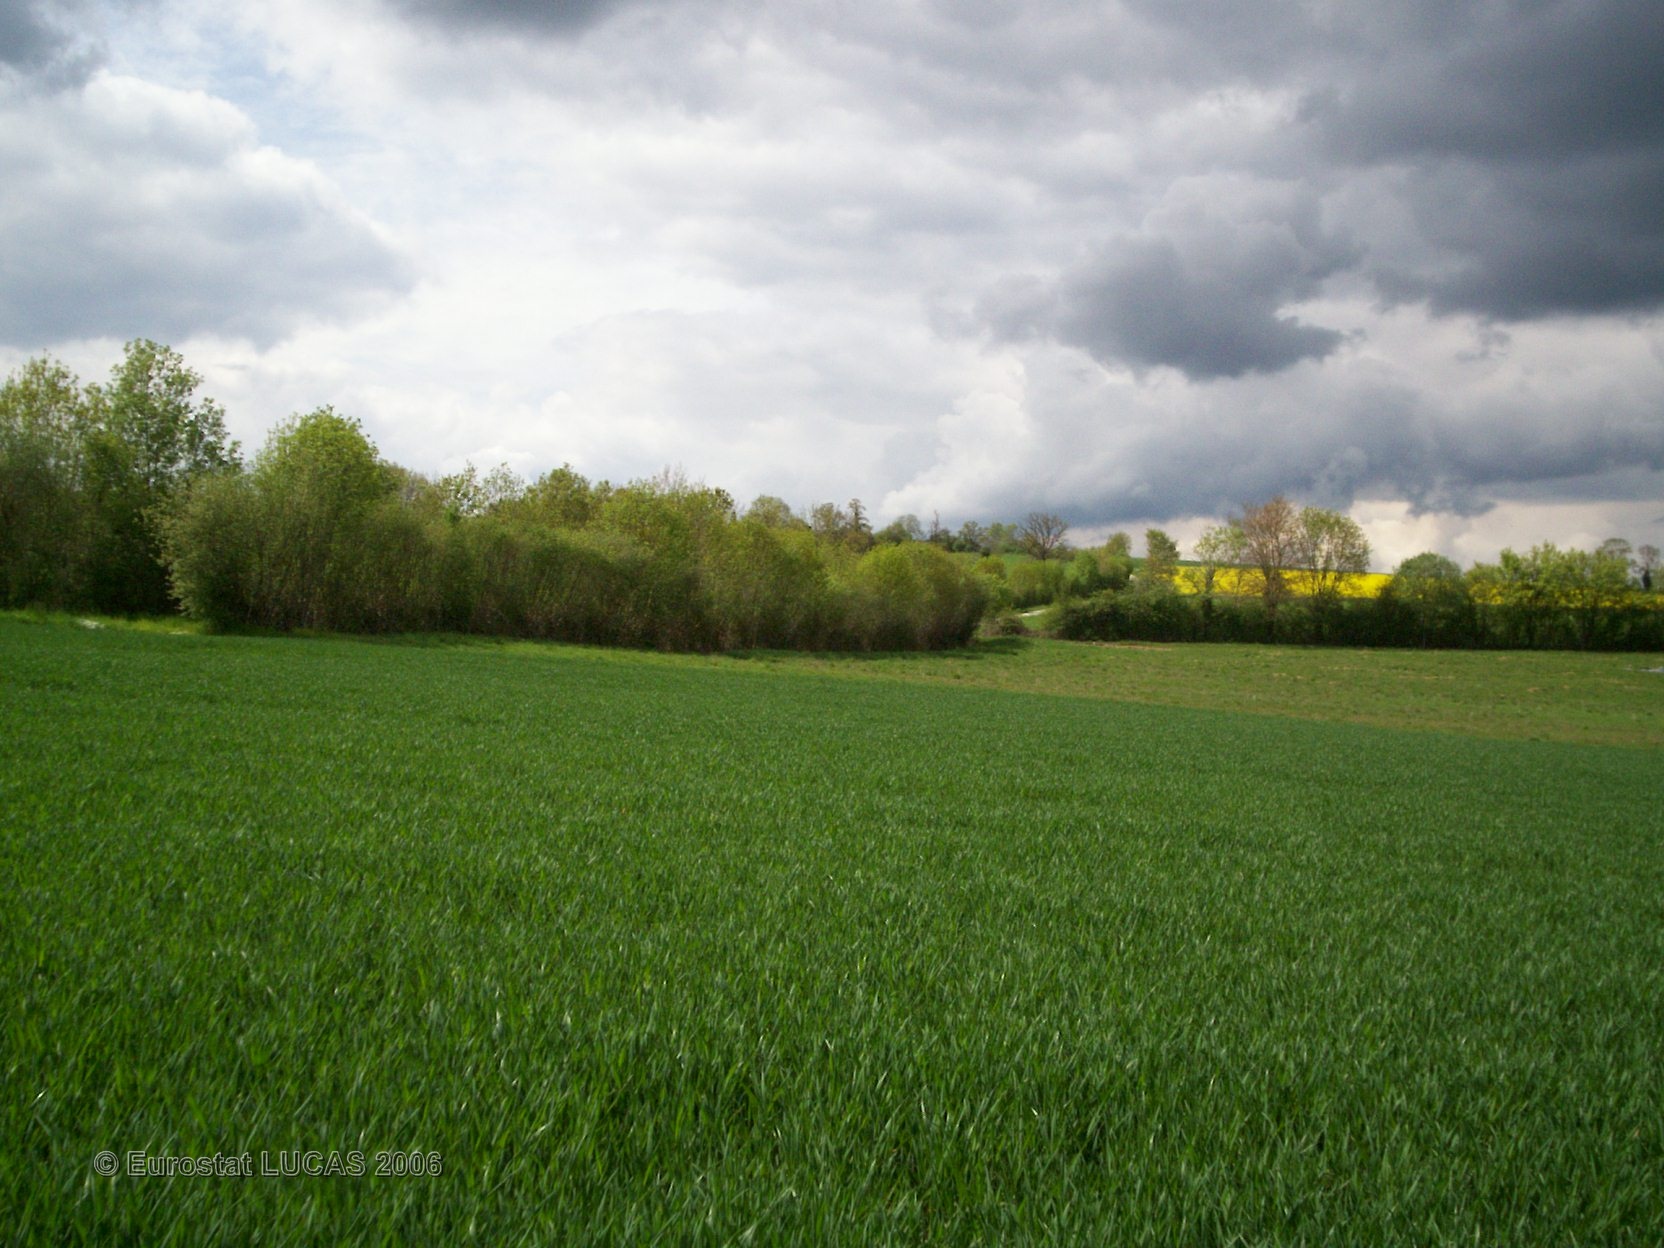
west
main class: Cropland
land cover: Common wheat
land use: Agriculture (excluding fallow land and kitchen gardens)
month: May
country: FR
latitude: 48.5890
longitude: 0.0603
